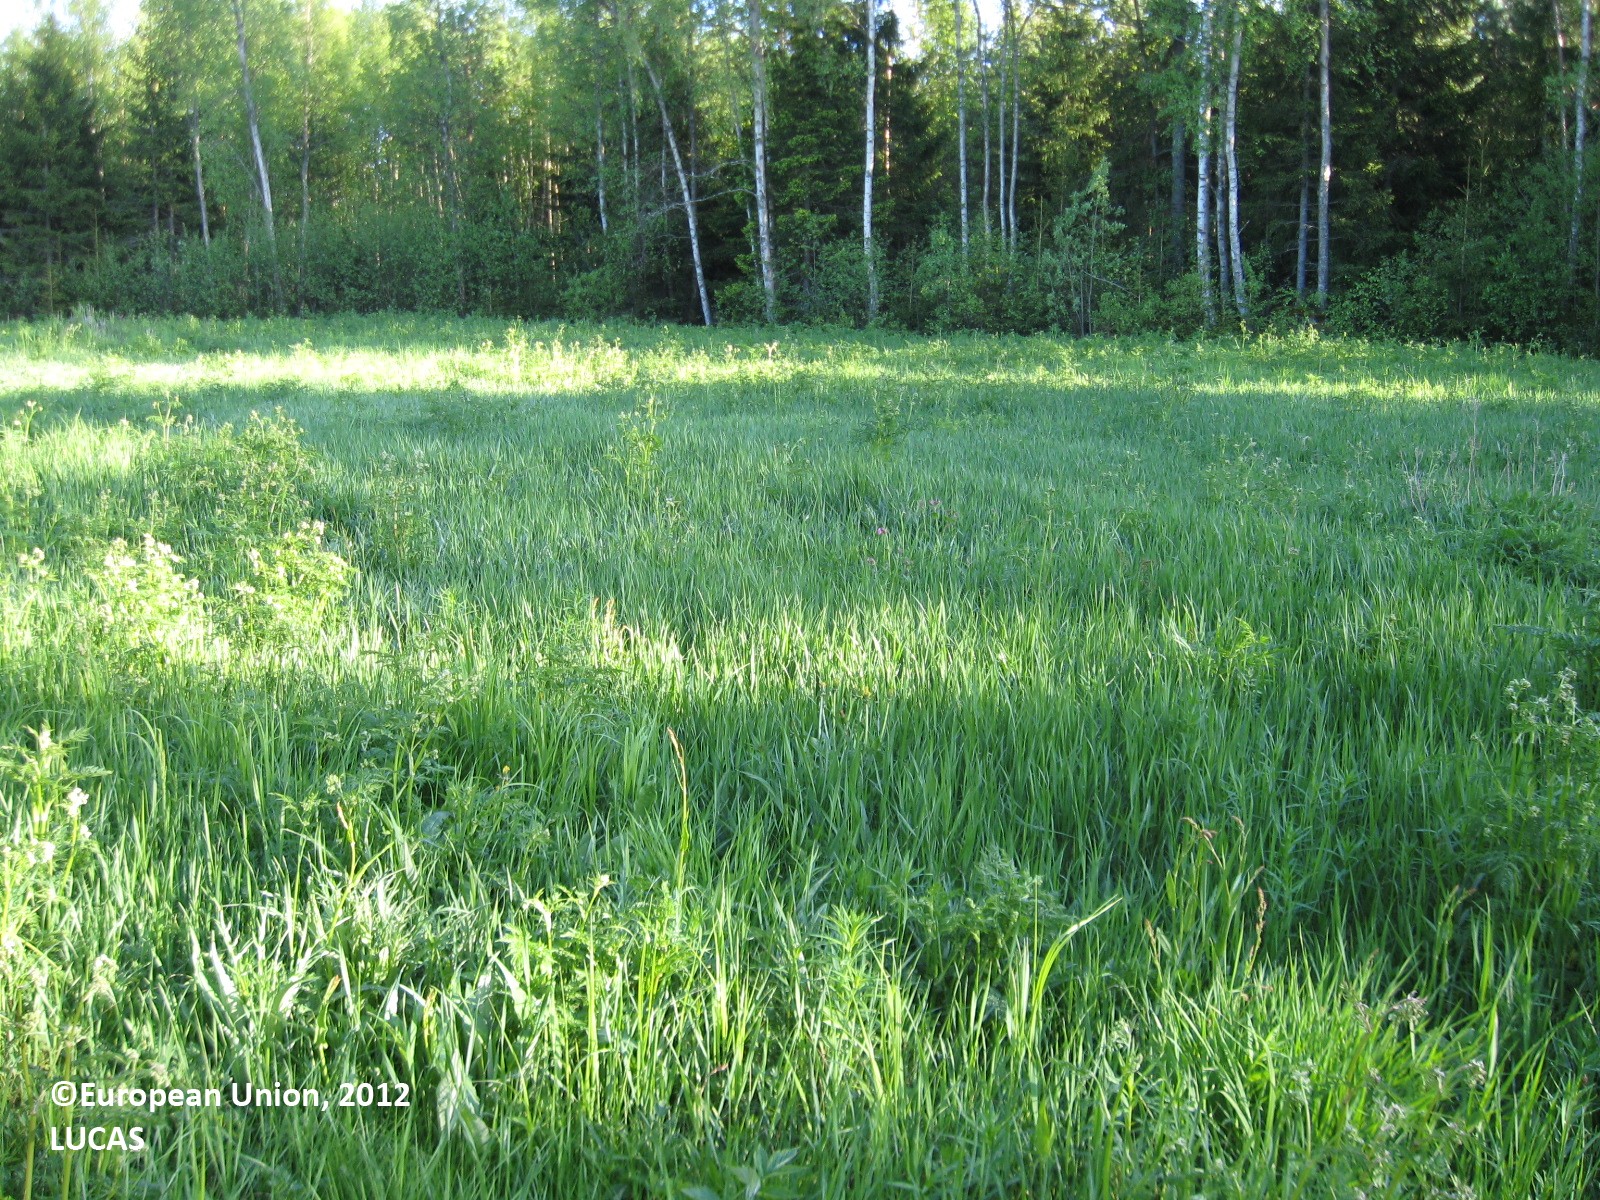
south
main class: Grassland
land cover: Grassland without tree/shrub cover
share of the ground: > 75 %
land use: Agriculture (excluding fallow land and kitchen gardens)
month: June
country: FI
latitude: 63.1422
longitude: 21.6866
